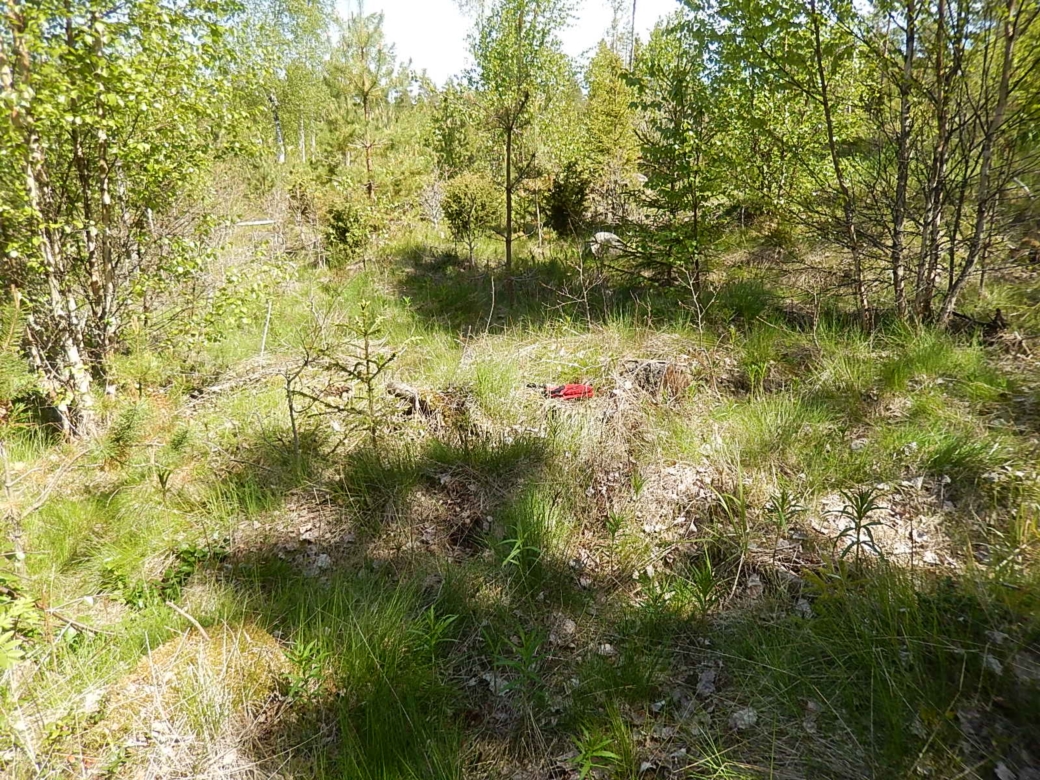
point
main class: Woodland
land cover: Other mixed woodland
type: boreal forest
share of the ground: 50 - 75 %
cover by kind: herbaceous plants 35 %, broadleaved forest trees 30 %, coniferous forest trees 20 %, lichens and mosses 10 %, shrubs 5 %
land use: Forestry
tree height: > 5 m
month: June
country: FI
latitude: 62.0987
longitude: 21.4821
